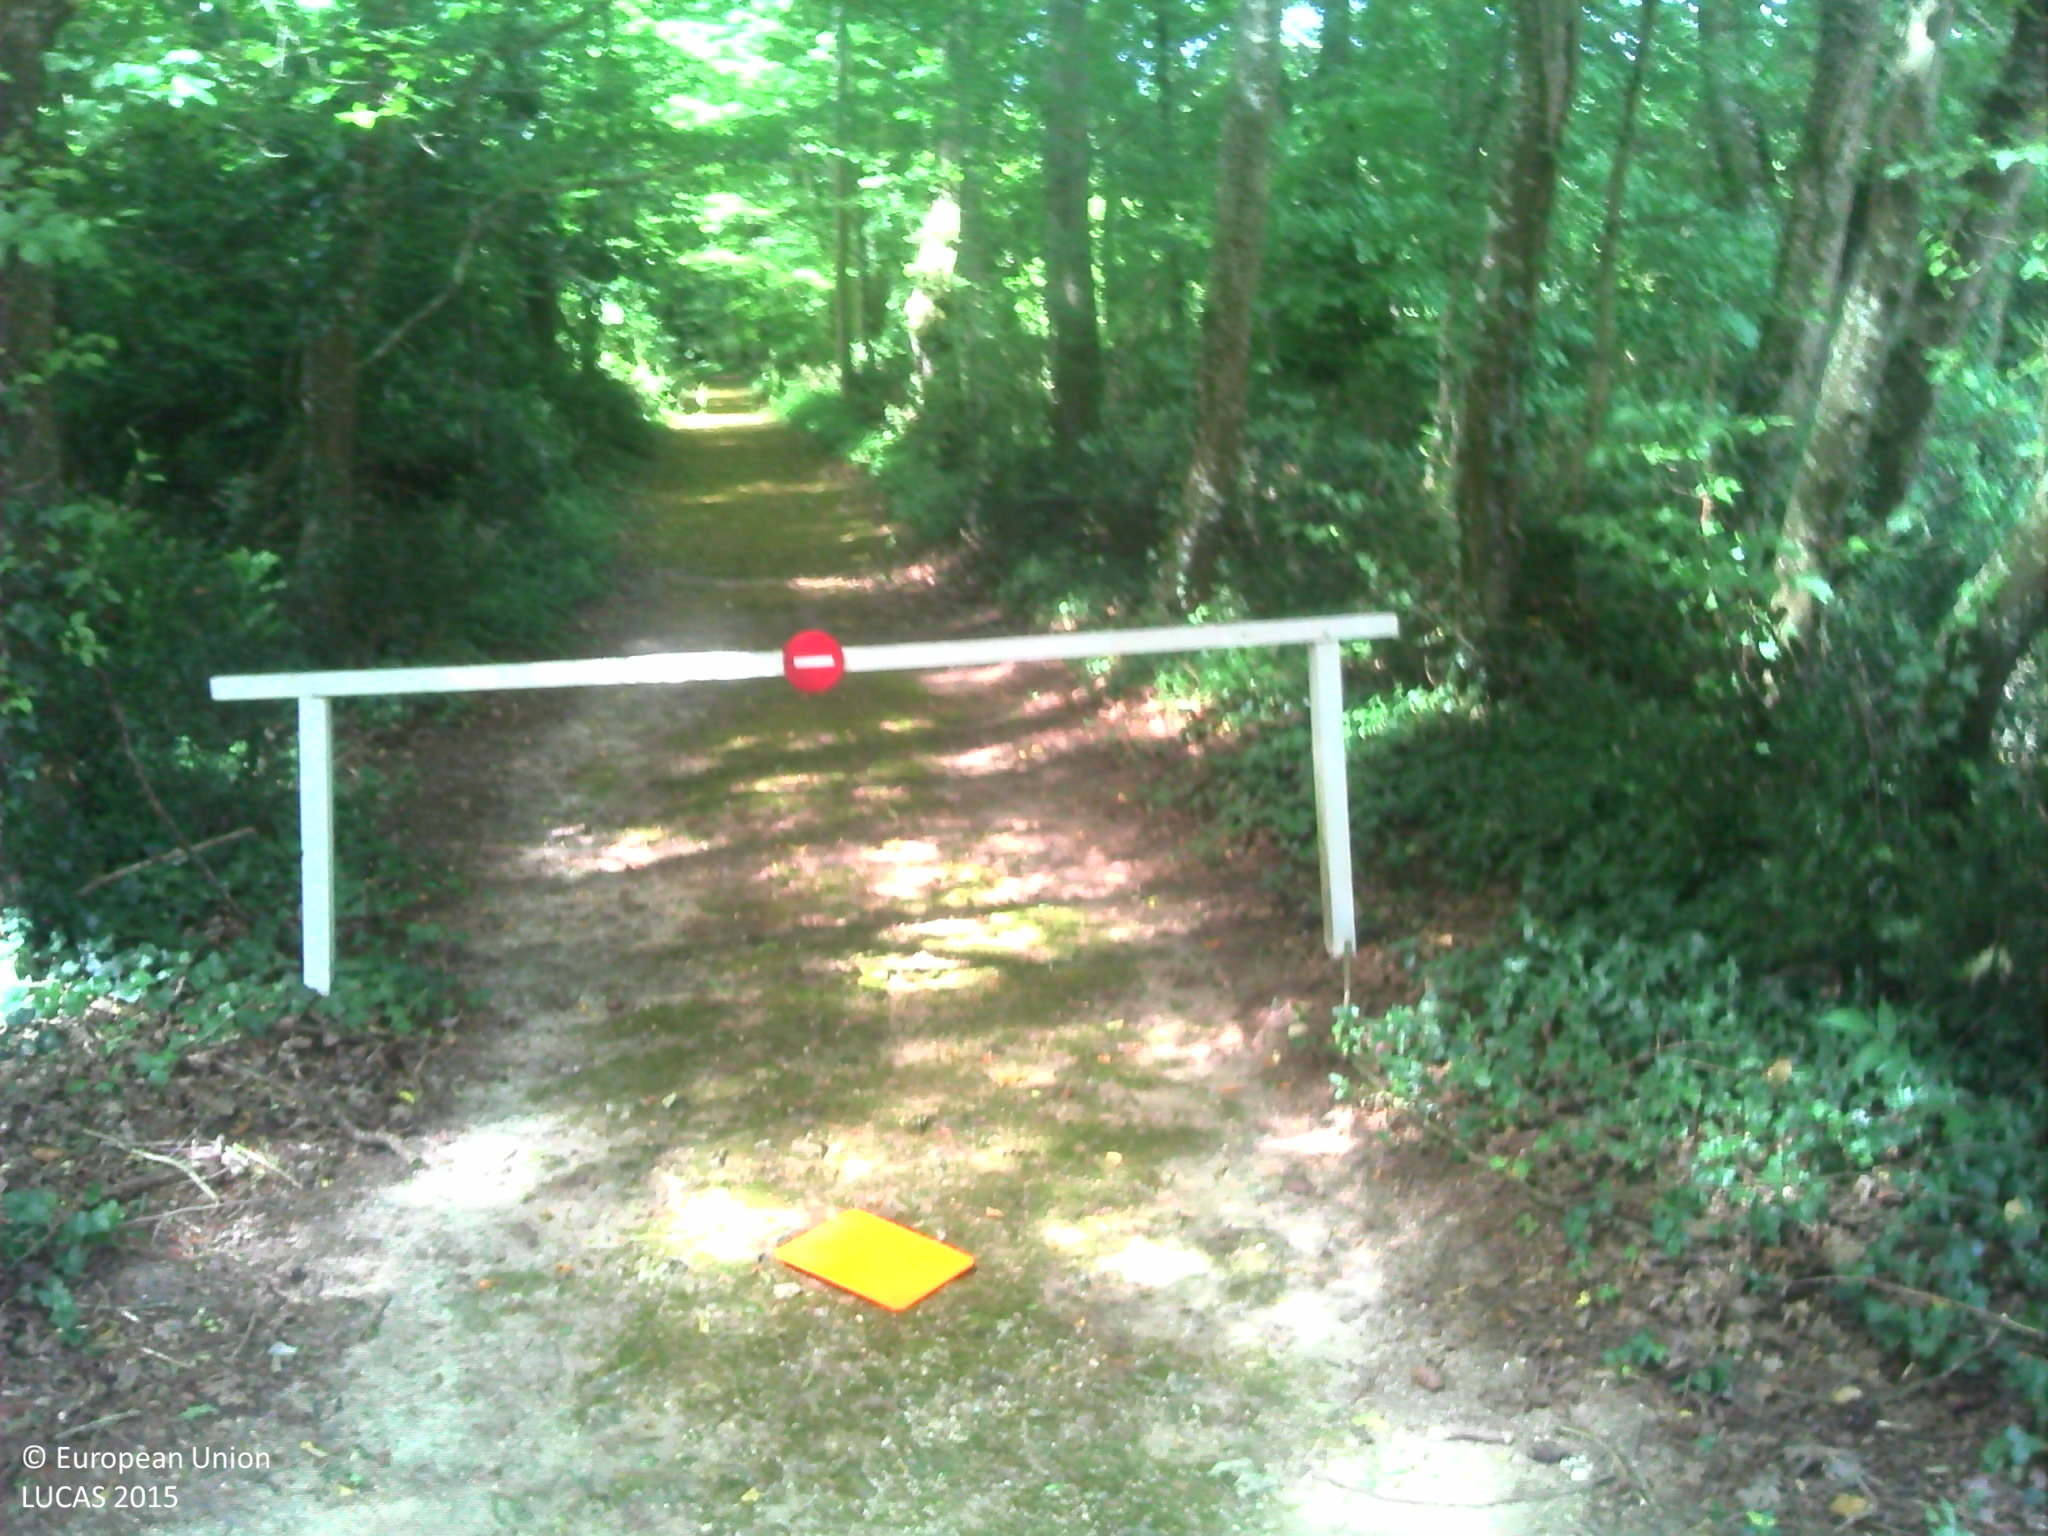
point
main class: Woodland
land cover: Broadleaved woodland
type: mesophytic deciduous forest
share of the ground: > 75 %
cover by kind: herbaceous plants 40 %, unconsolidated bare surface 40 %, broadleaved forest trees 20 %
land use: Residential
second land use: Amenities, museums, leisure
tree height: > 5 m
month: June
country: FR
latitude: 47.4908
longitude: 1.4246
